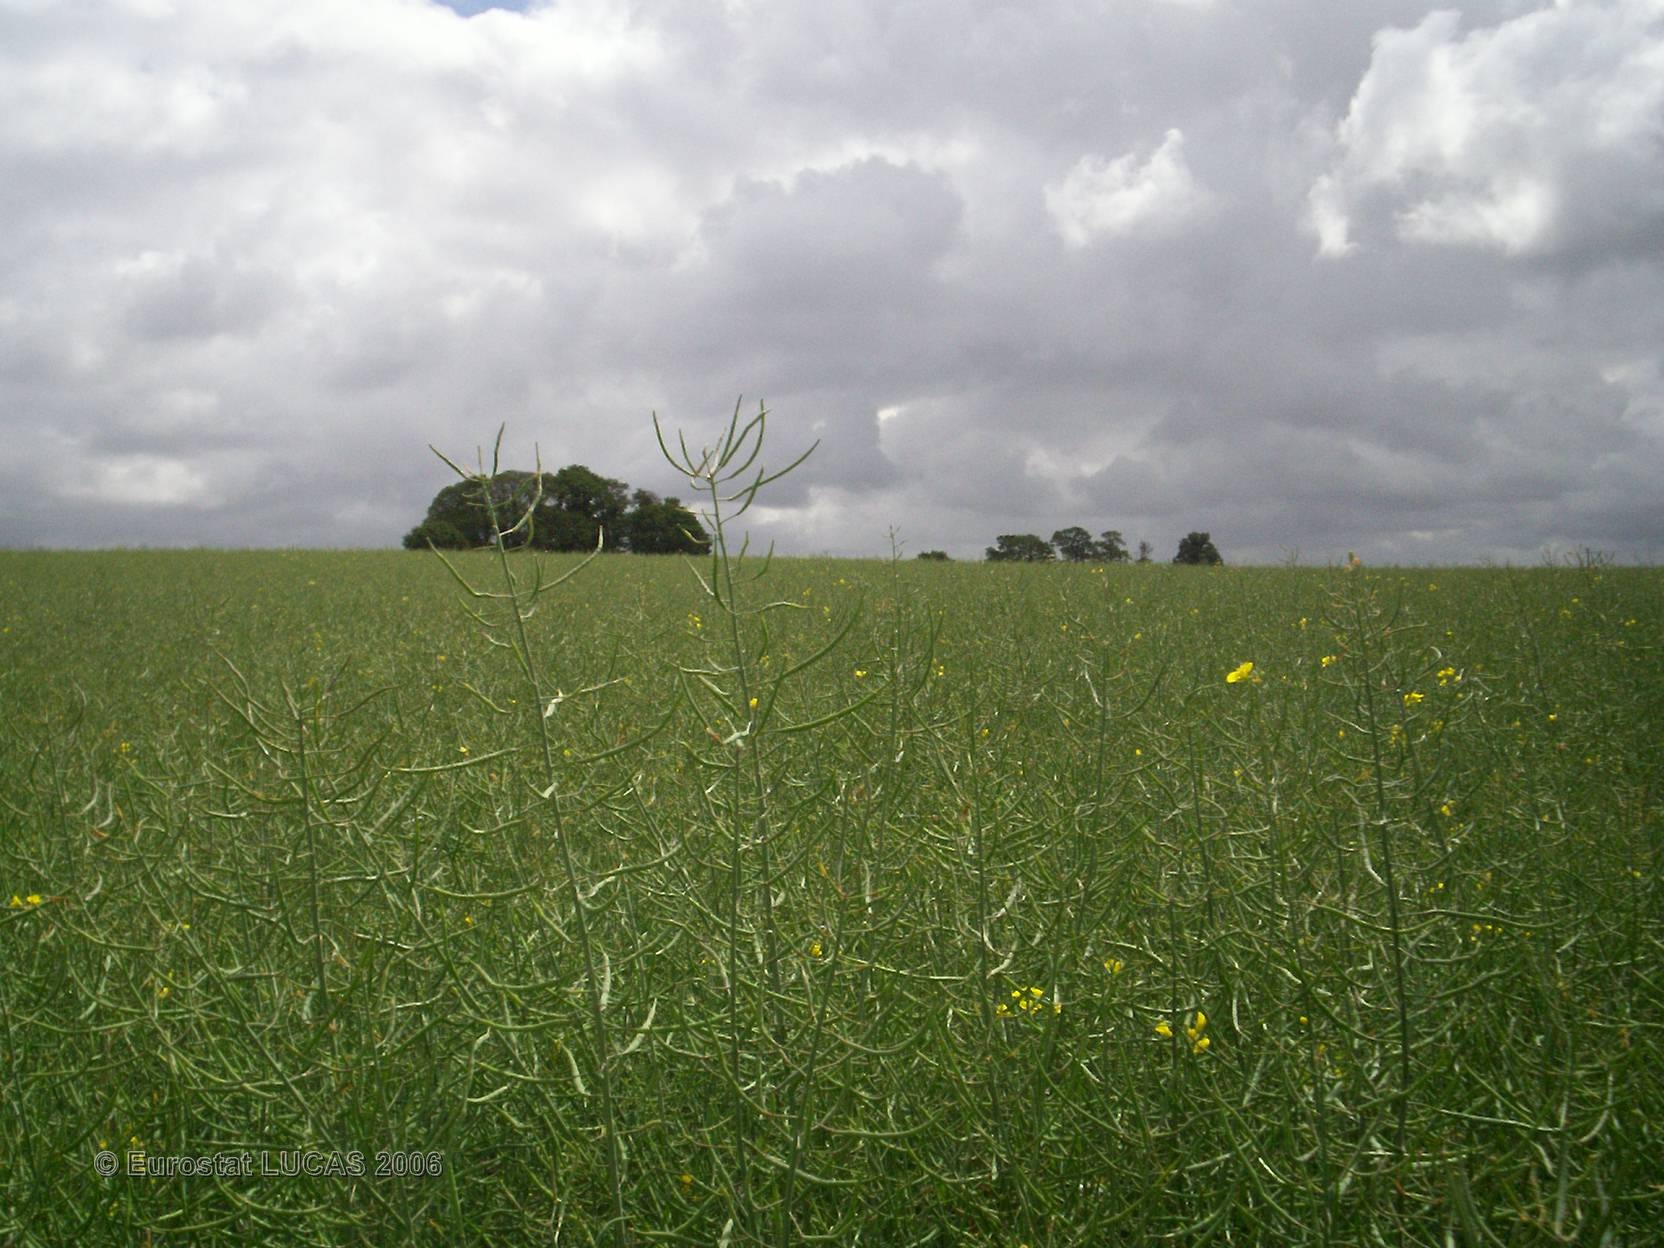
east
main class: Cropland
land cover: Rape and turnip rape
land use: Agriculture (excluding fallow land and kitchen gardens)
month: May
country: FR
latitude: 47.9445
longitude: -2.8235
